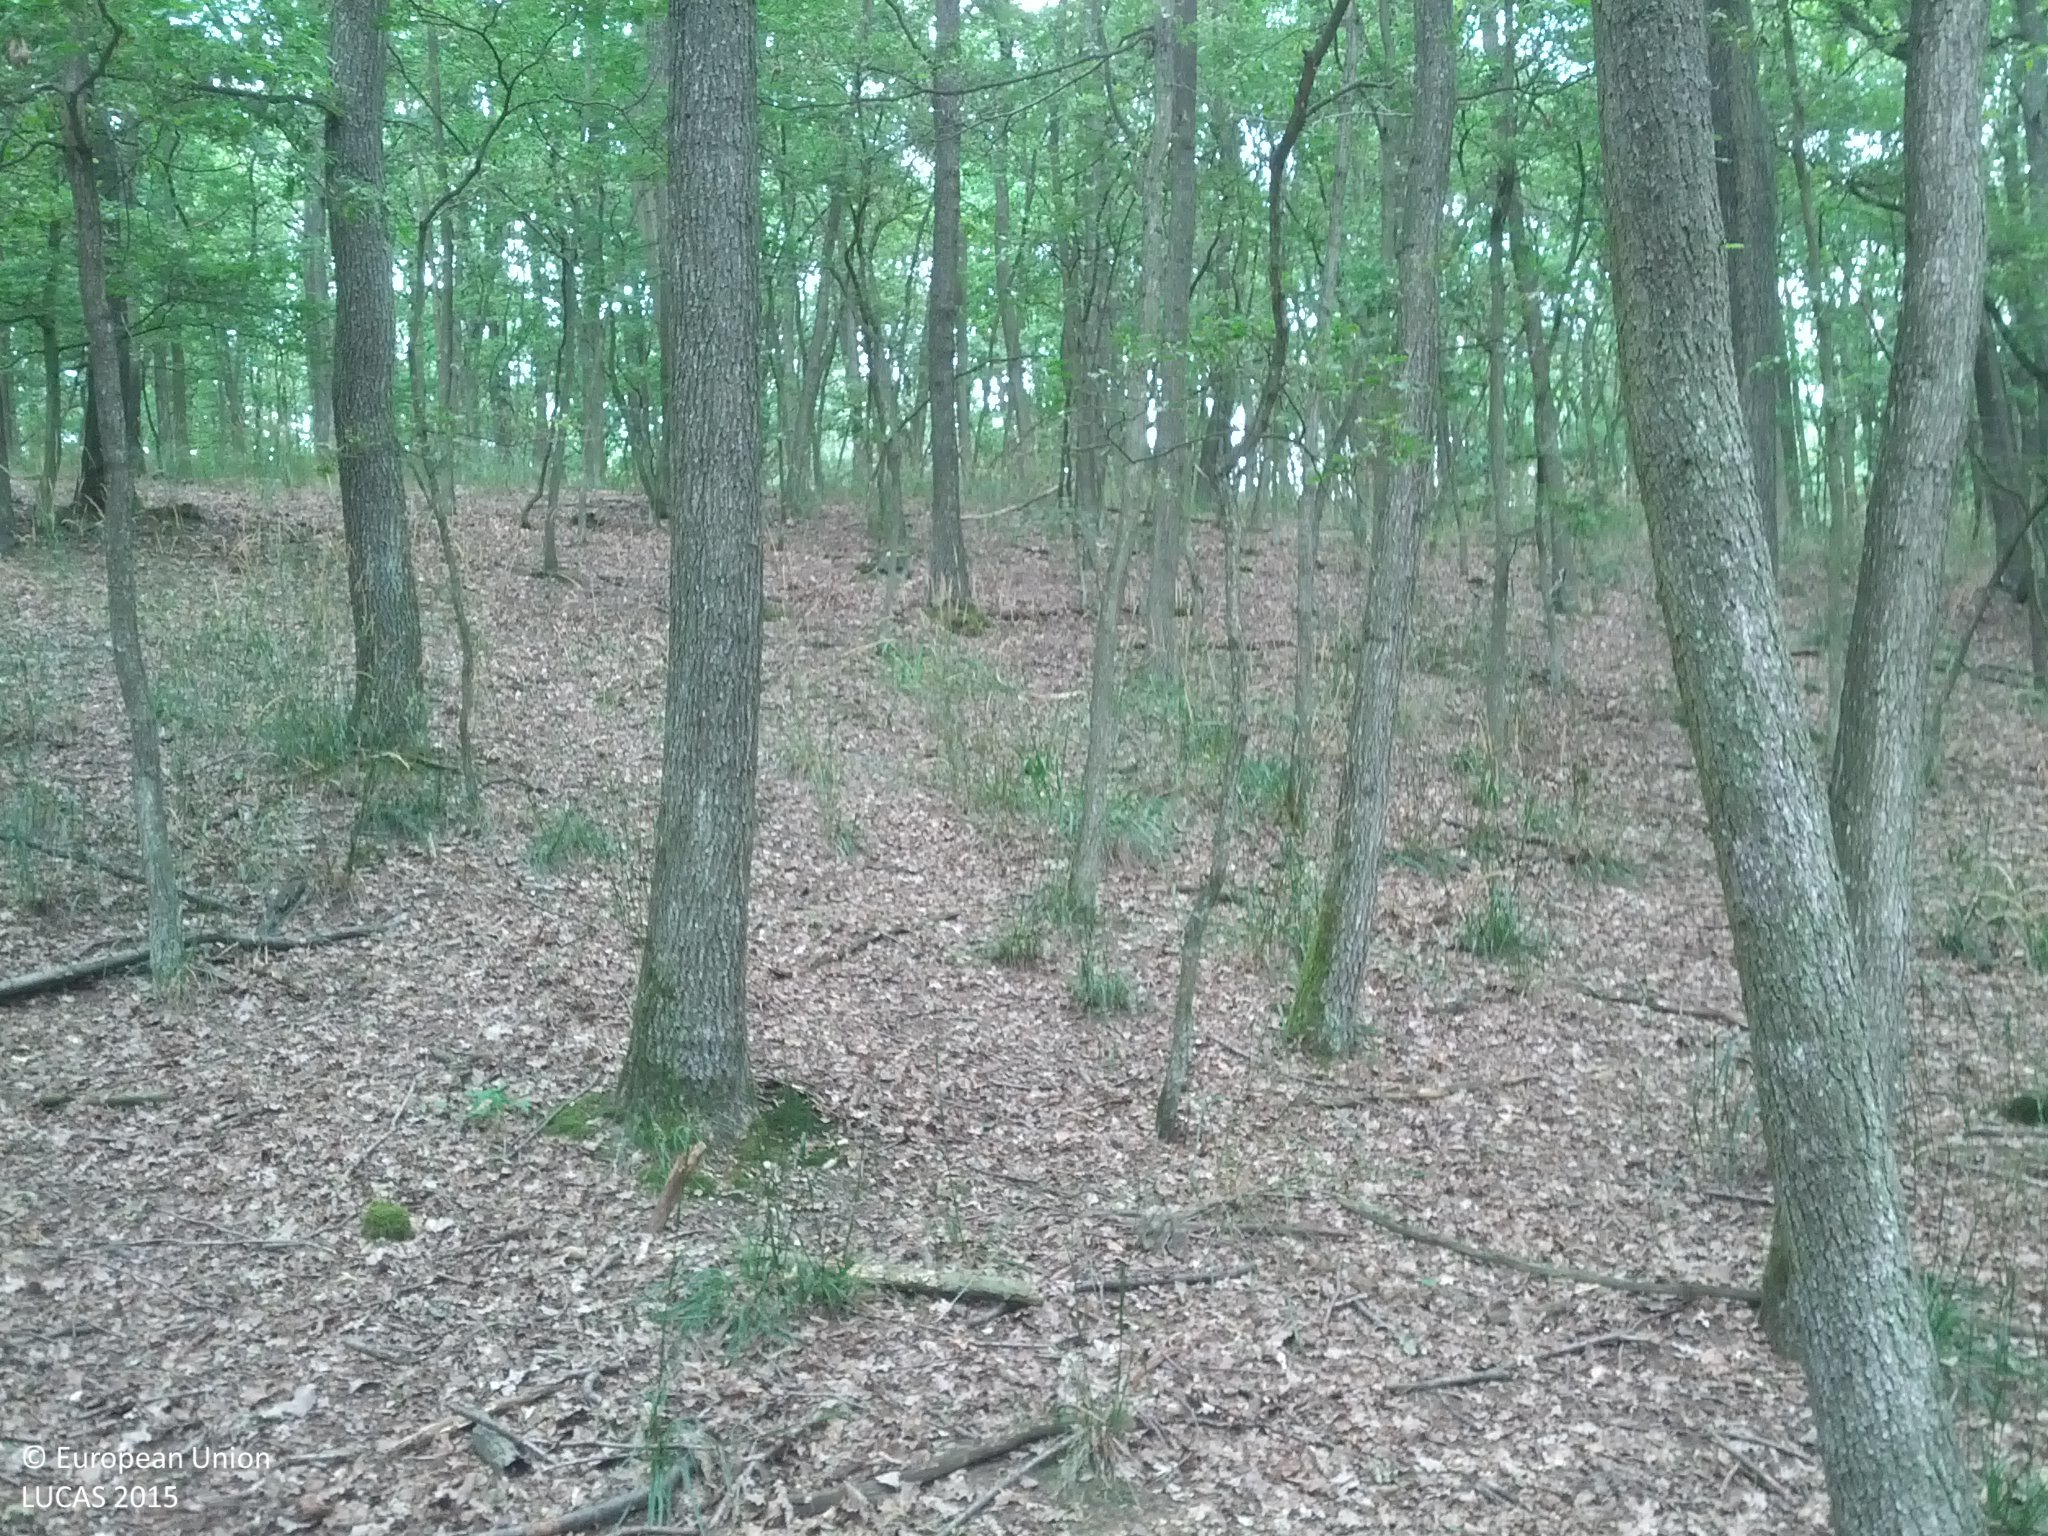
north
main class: Woodland
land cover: Broadleaved woodland
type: acidophilous oak and oak-birch forest
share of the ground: > 75 %
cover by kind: broadleaved forest trees 90 %, herbaceous plants 10 %
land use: Forestry
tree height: > 5 m
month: July
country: AT
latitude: 48.5396
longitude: 16.1403
